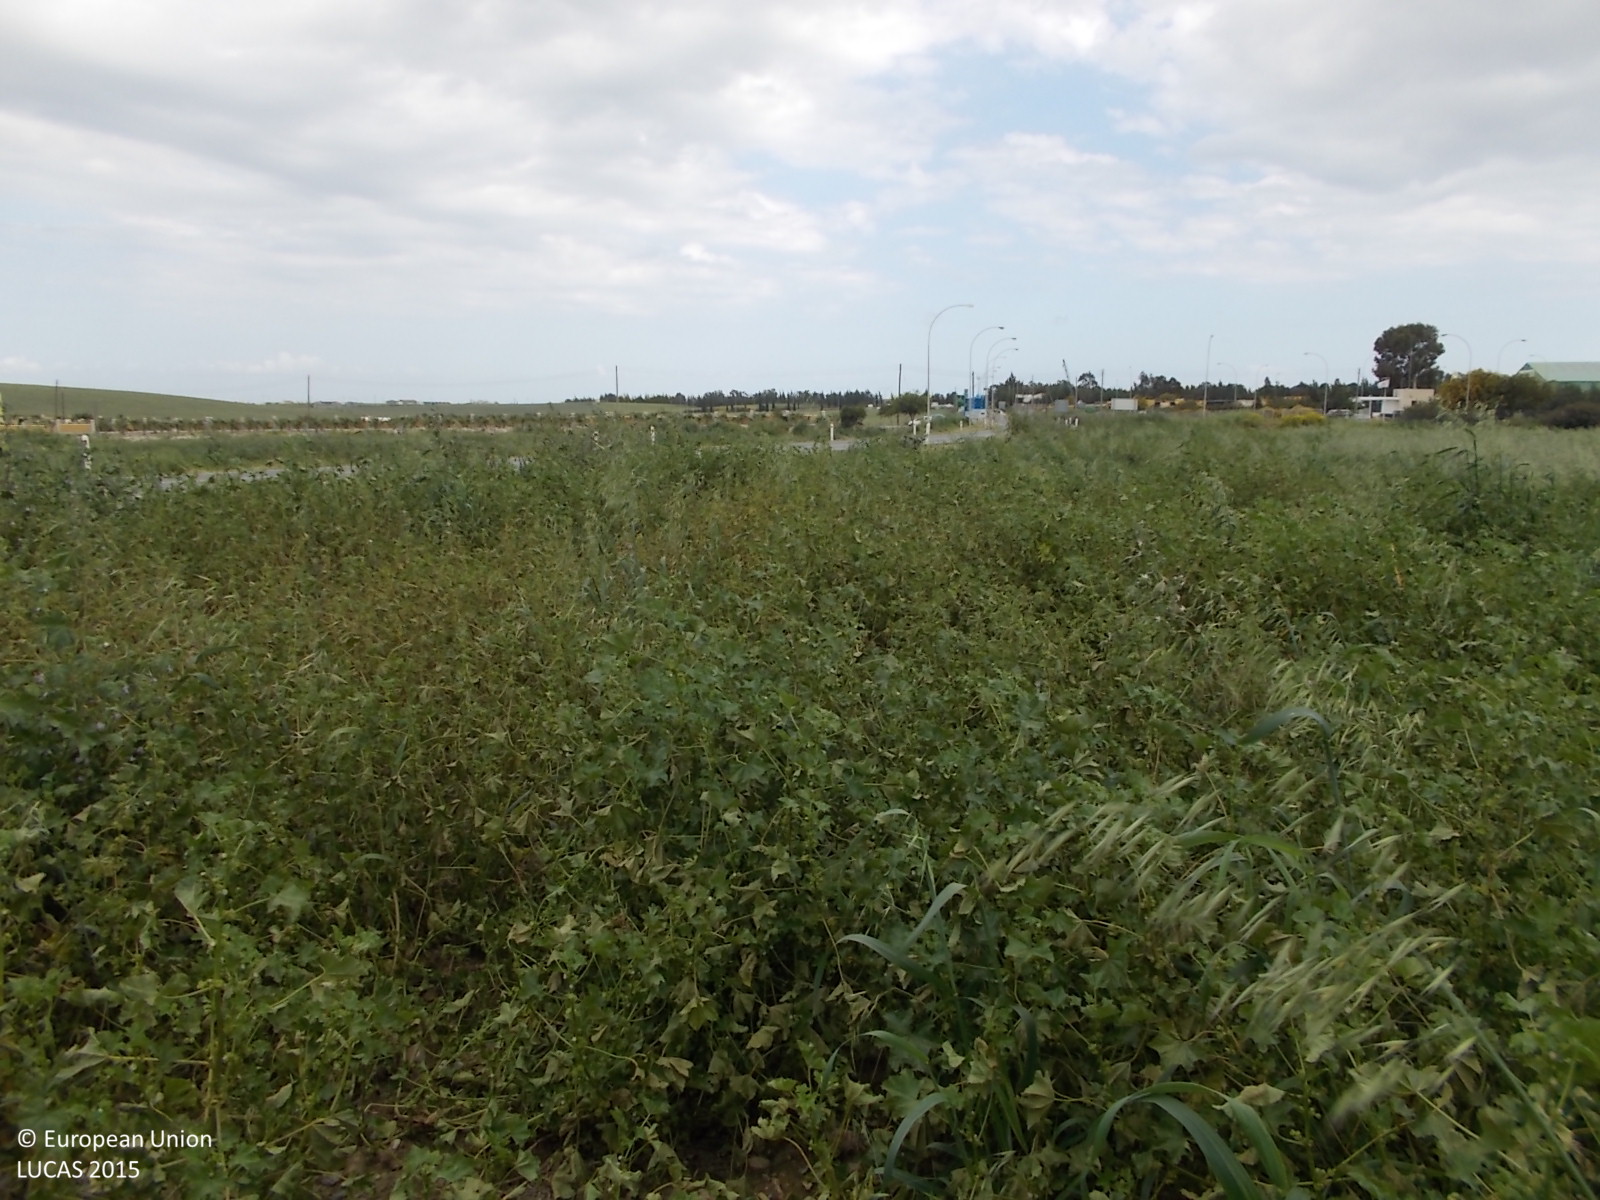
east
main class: Cropland
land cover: Other fresh vegetables
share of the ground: > 75 %
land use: Agriculture (excluding fallow land and kitchen gardens)
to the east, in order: Other fresh vegetables; Grass margins; Paved roads, cycling and walking lanes; Grass margins; Barley; Spontaneously vegetated surfaces; Other bare soil; Lines of trees; Other bare soil; Lines of trees; Paved roads, cycling and walking lanes; Lines of trees; Electric lines; Fences; Other bare soil; Tracks; Spontaneously vegetated surfaces; Other bare soil
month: April
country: CY
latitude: 34.9115
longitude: 33.5609
